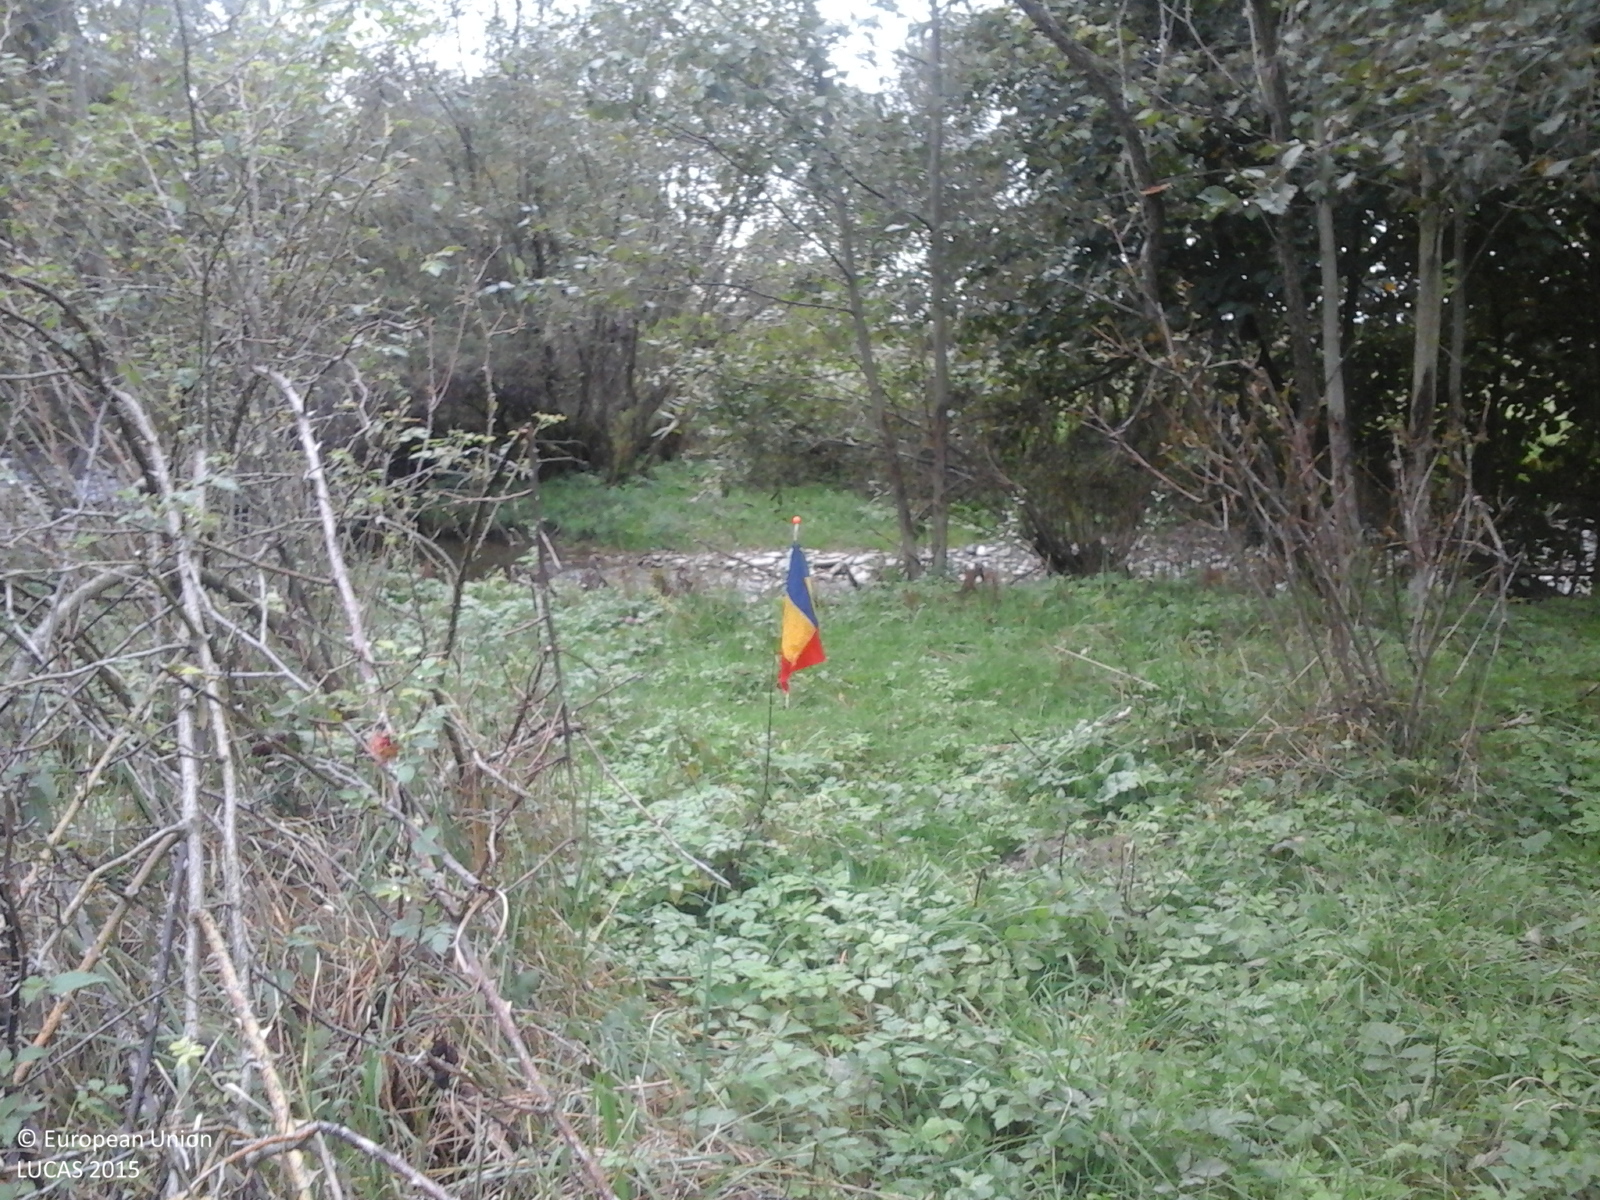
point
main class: Woodland
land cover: Other mixed woodland
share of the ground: > 75 %
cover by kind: broadleaved forest trees 65 %, coniferous forest trees 25 %, herbaceous plants 10 %
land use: Forestry
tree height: < 5 m
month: October
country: RO
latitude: 45.7140
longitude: 24.8225
